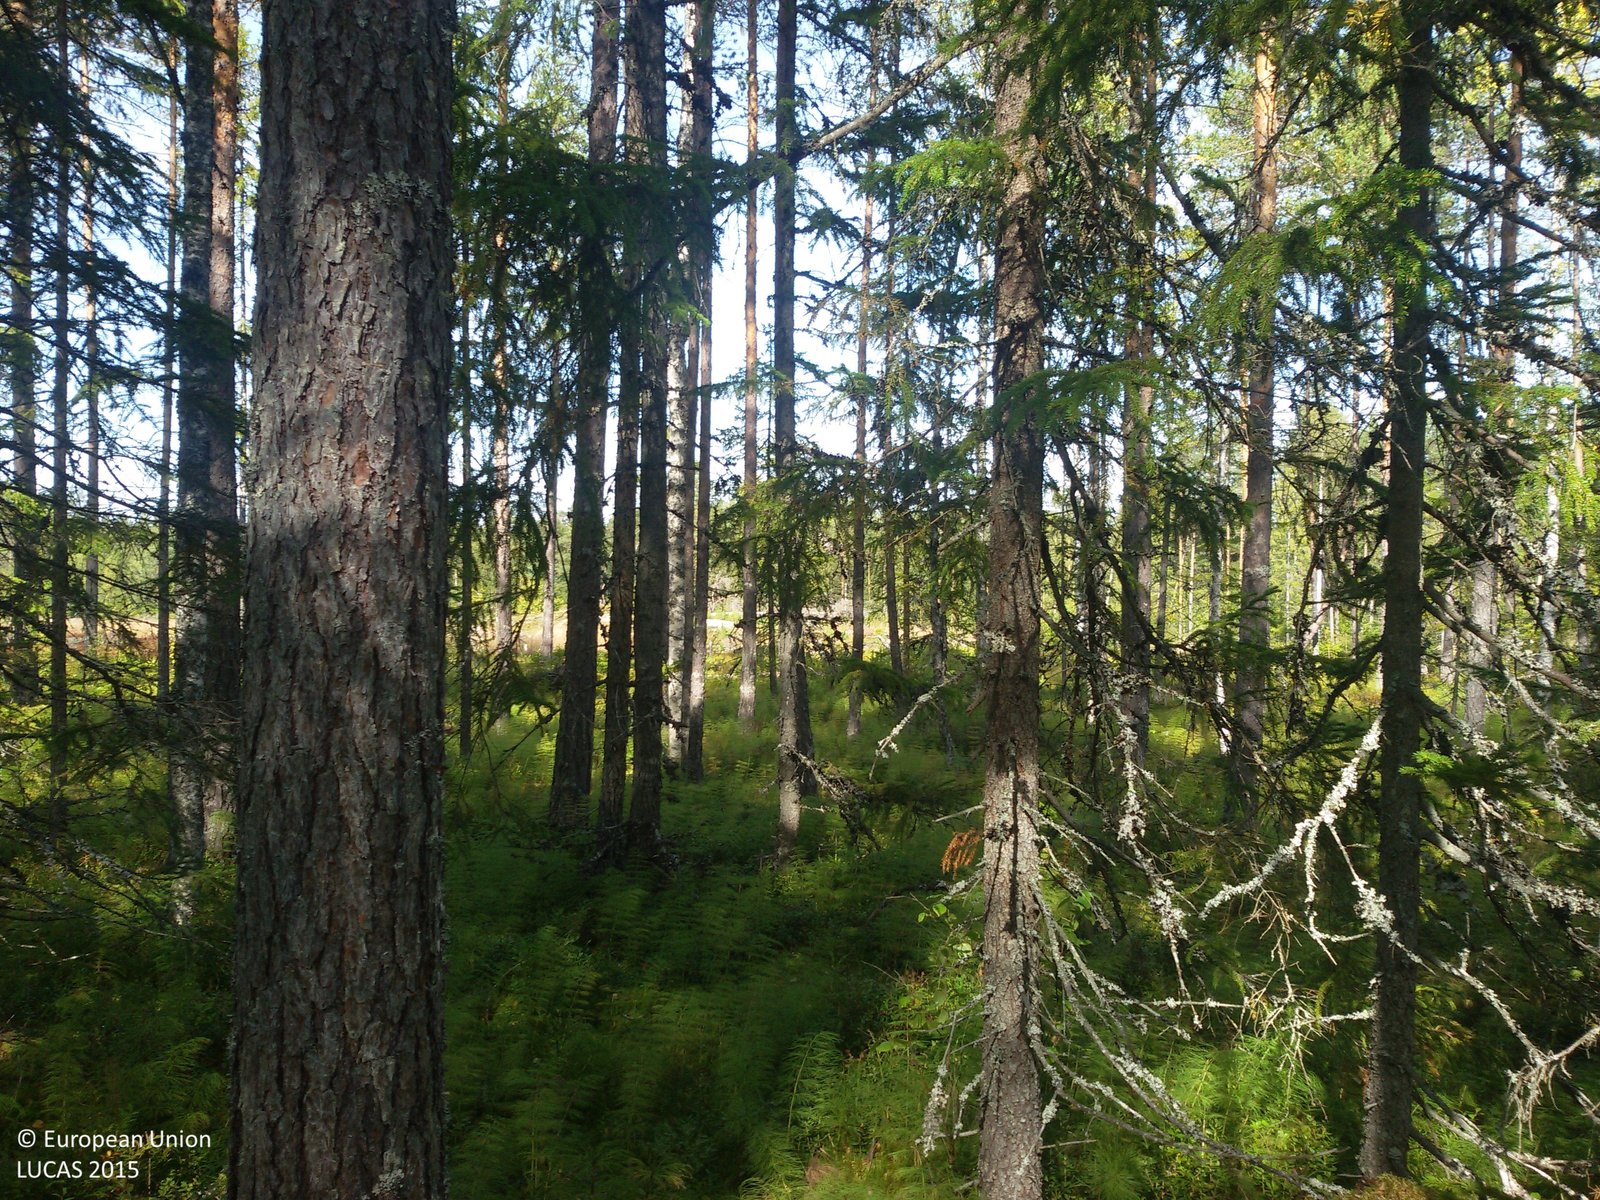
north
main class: Woodland
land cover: Pine dominated mixed woodland
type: boreal forest
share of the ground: 50 - 75 %
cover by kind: coniferous forest trees 40 %, broadleaved forest trees 30 %, lichens and mosses 20 %, herbaceous plants 10 %
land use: Forestry
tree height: > 5 m
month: September
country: SE
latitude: 61.0020
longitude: 15.2931
